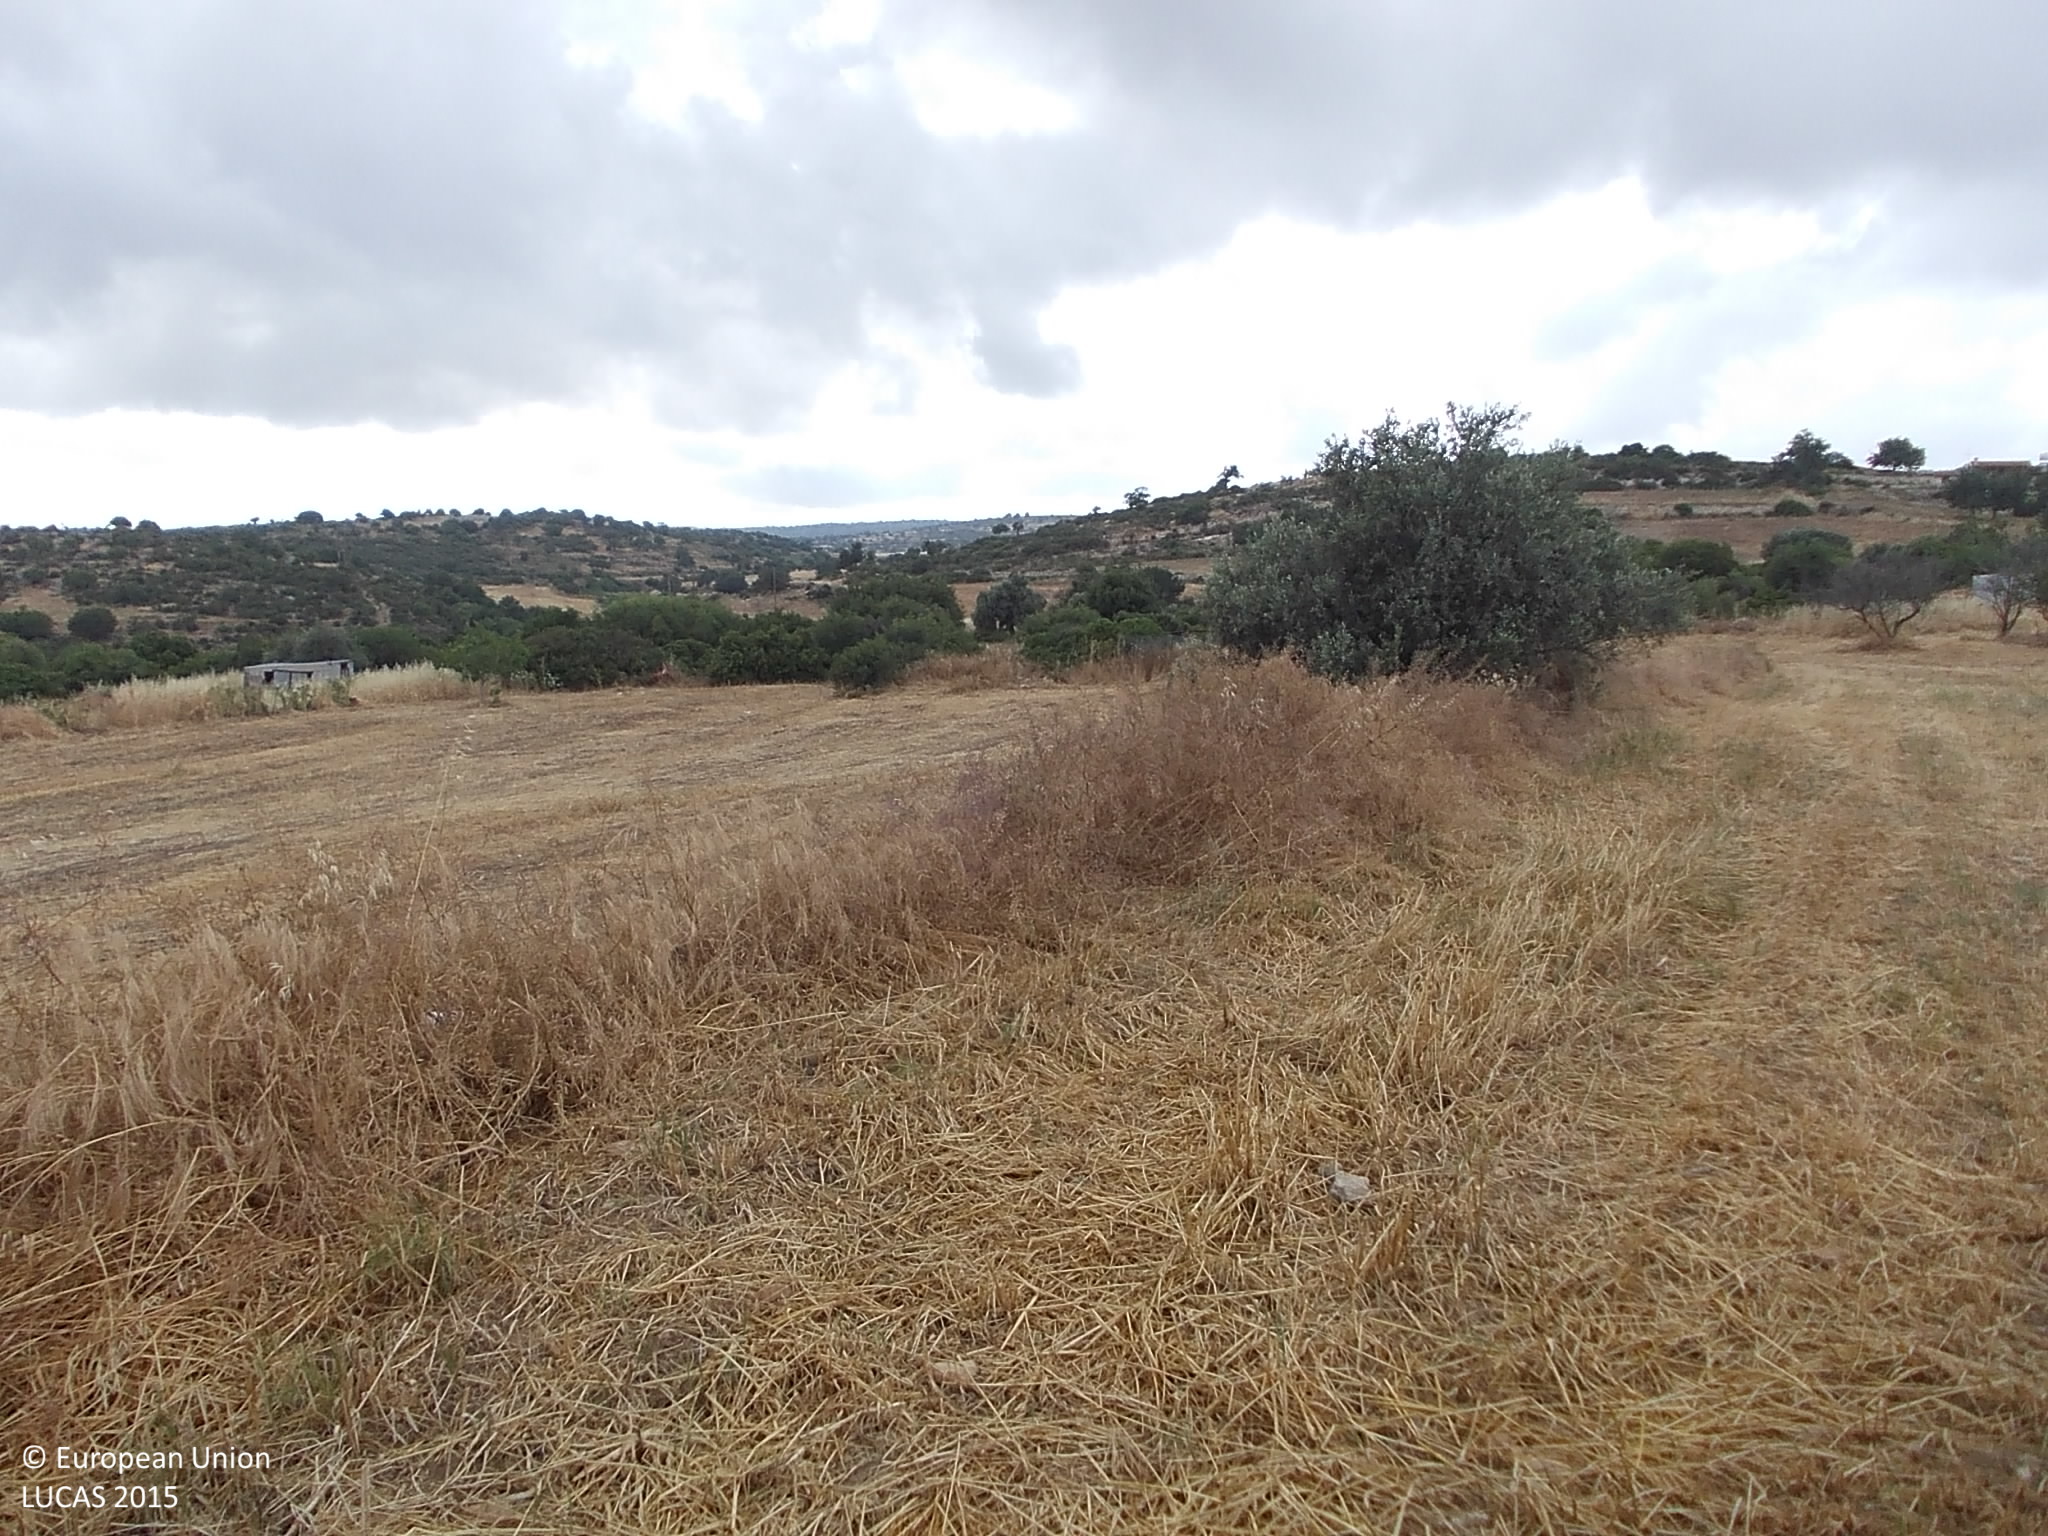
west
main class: Cropland
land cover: Olive groves
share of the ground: 10 - 25 %
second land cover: Other bare soil
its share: > 75 %
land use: Agriculture (excluding fallow land and kitchen gardens)
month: May
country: CY
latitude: 34.7558
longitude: 32.7818
